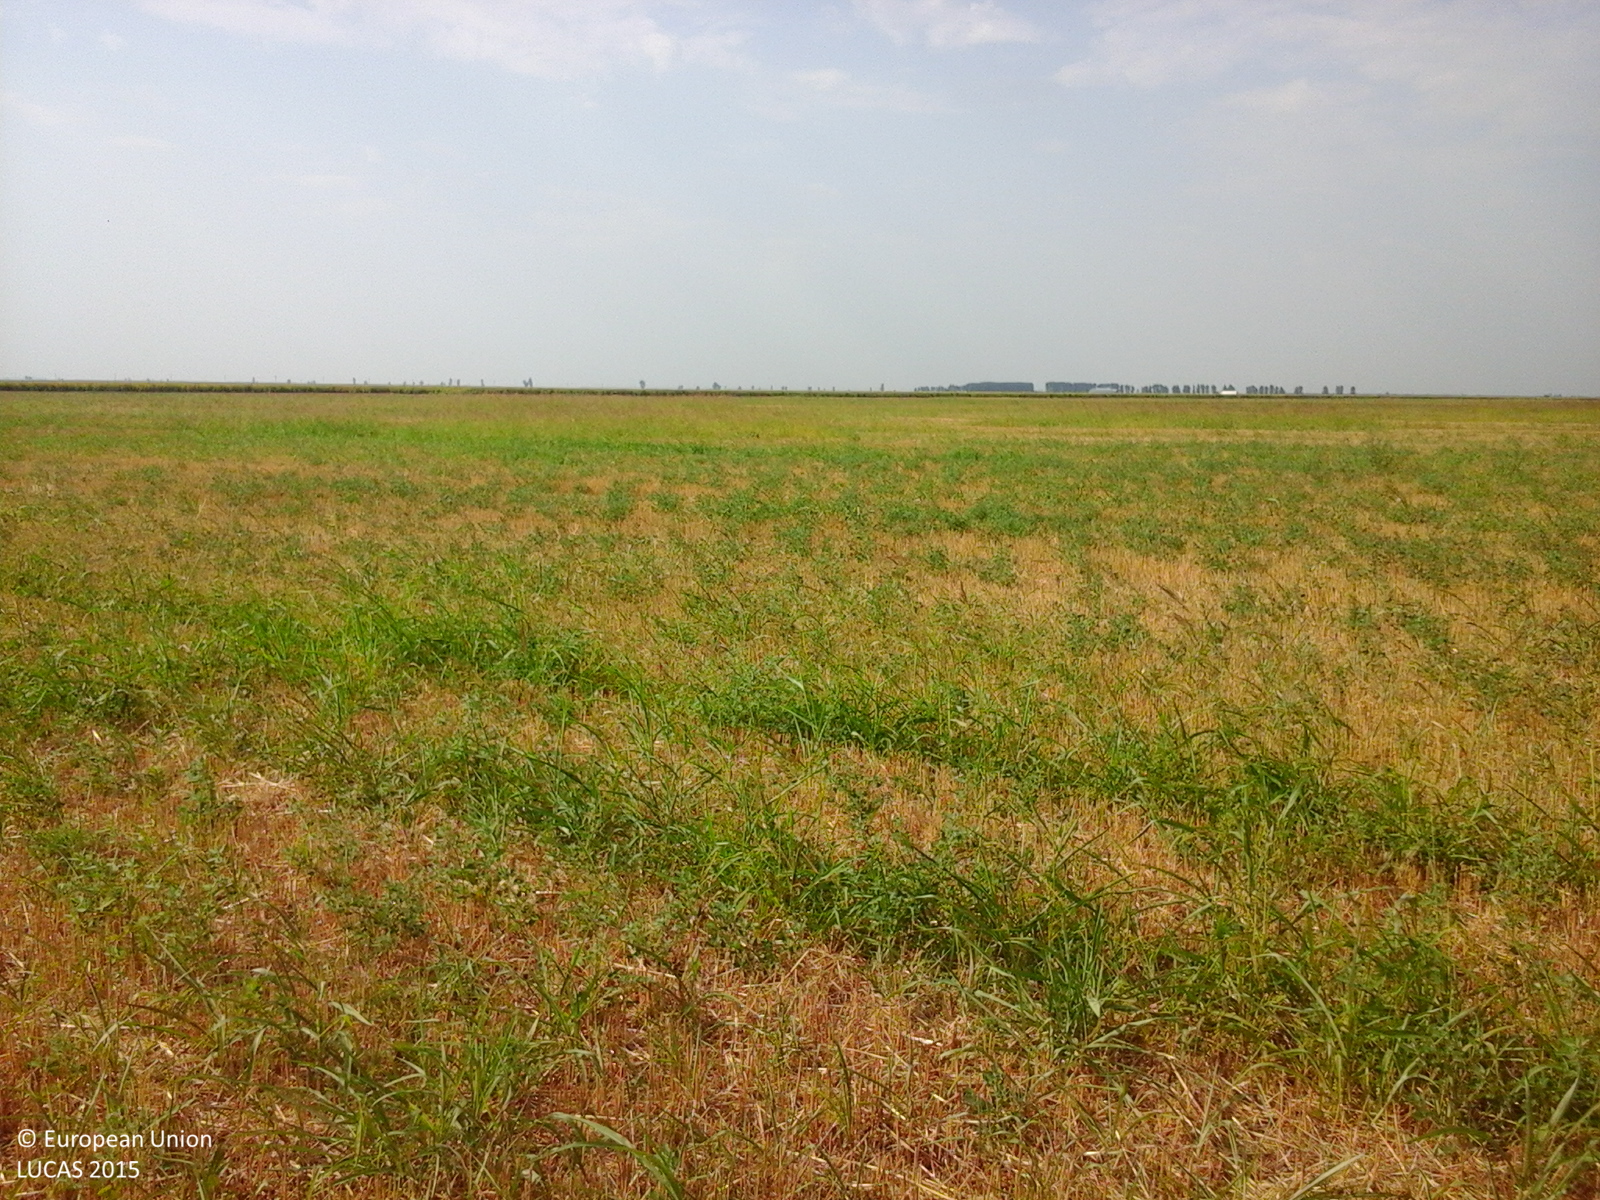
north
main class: Cropland
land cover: Common wheat
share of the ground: > 75 %
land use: Agriculture (excluding fallow land and kitchen gardens)
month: August
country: RO
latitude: 45.0197
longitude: 27.6268
